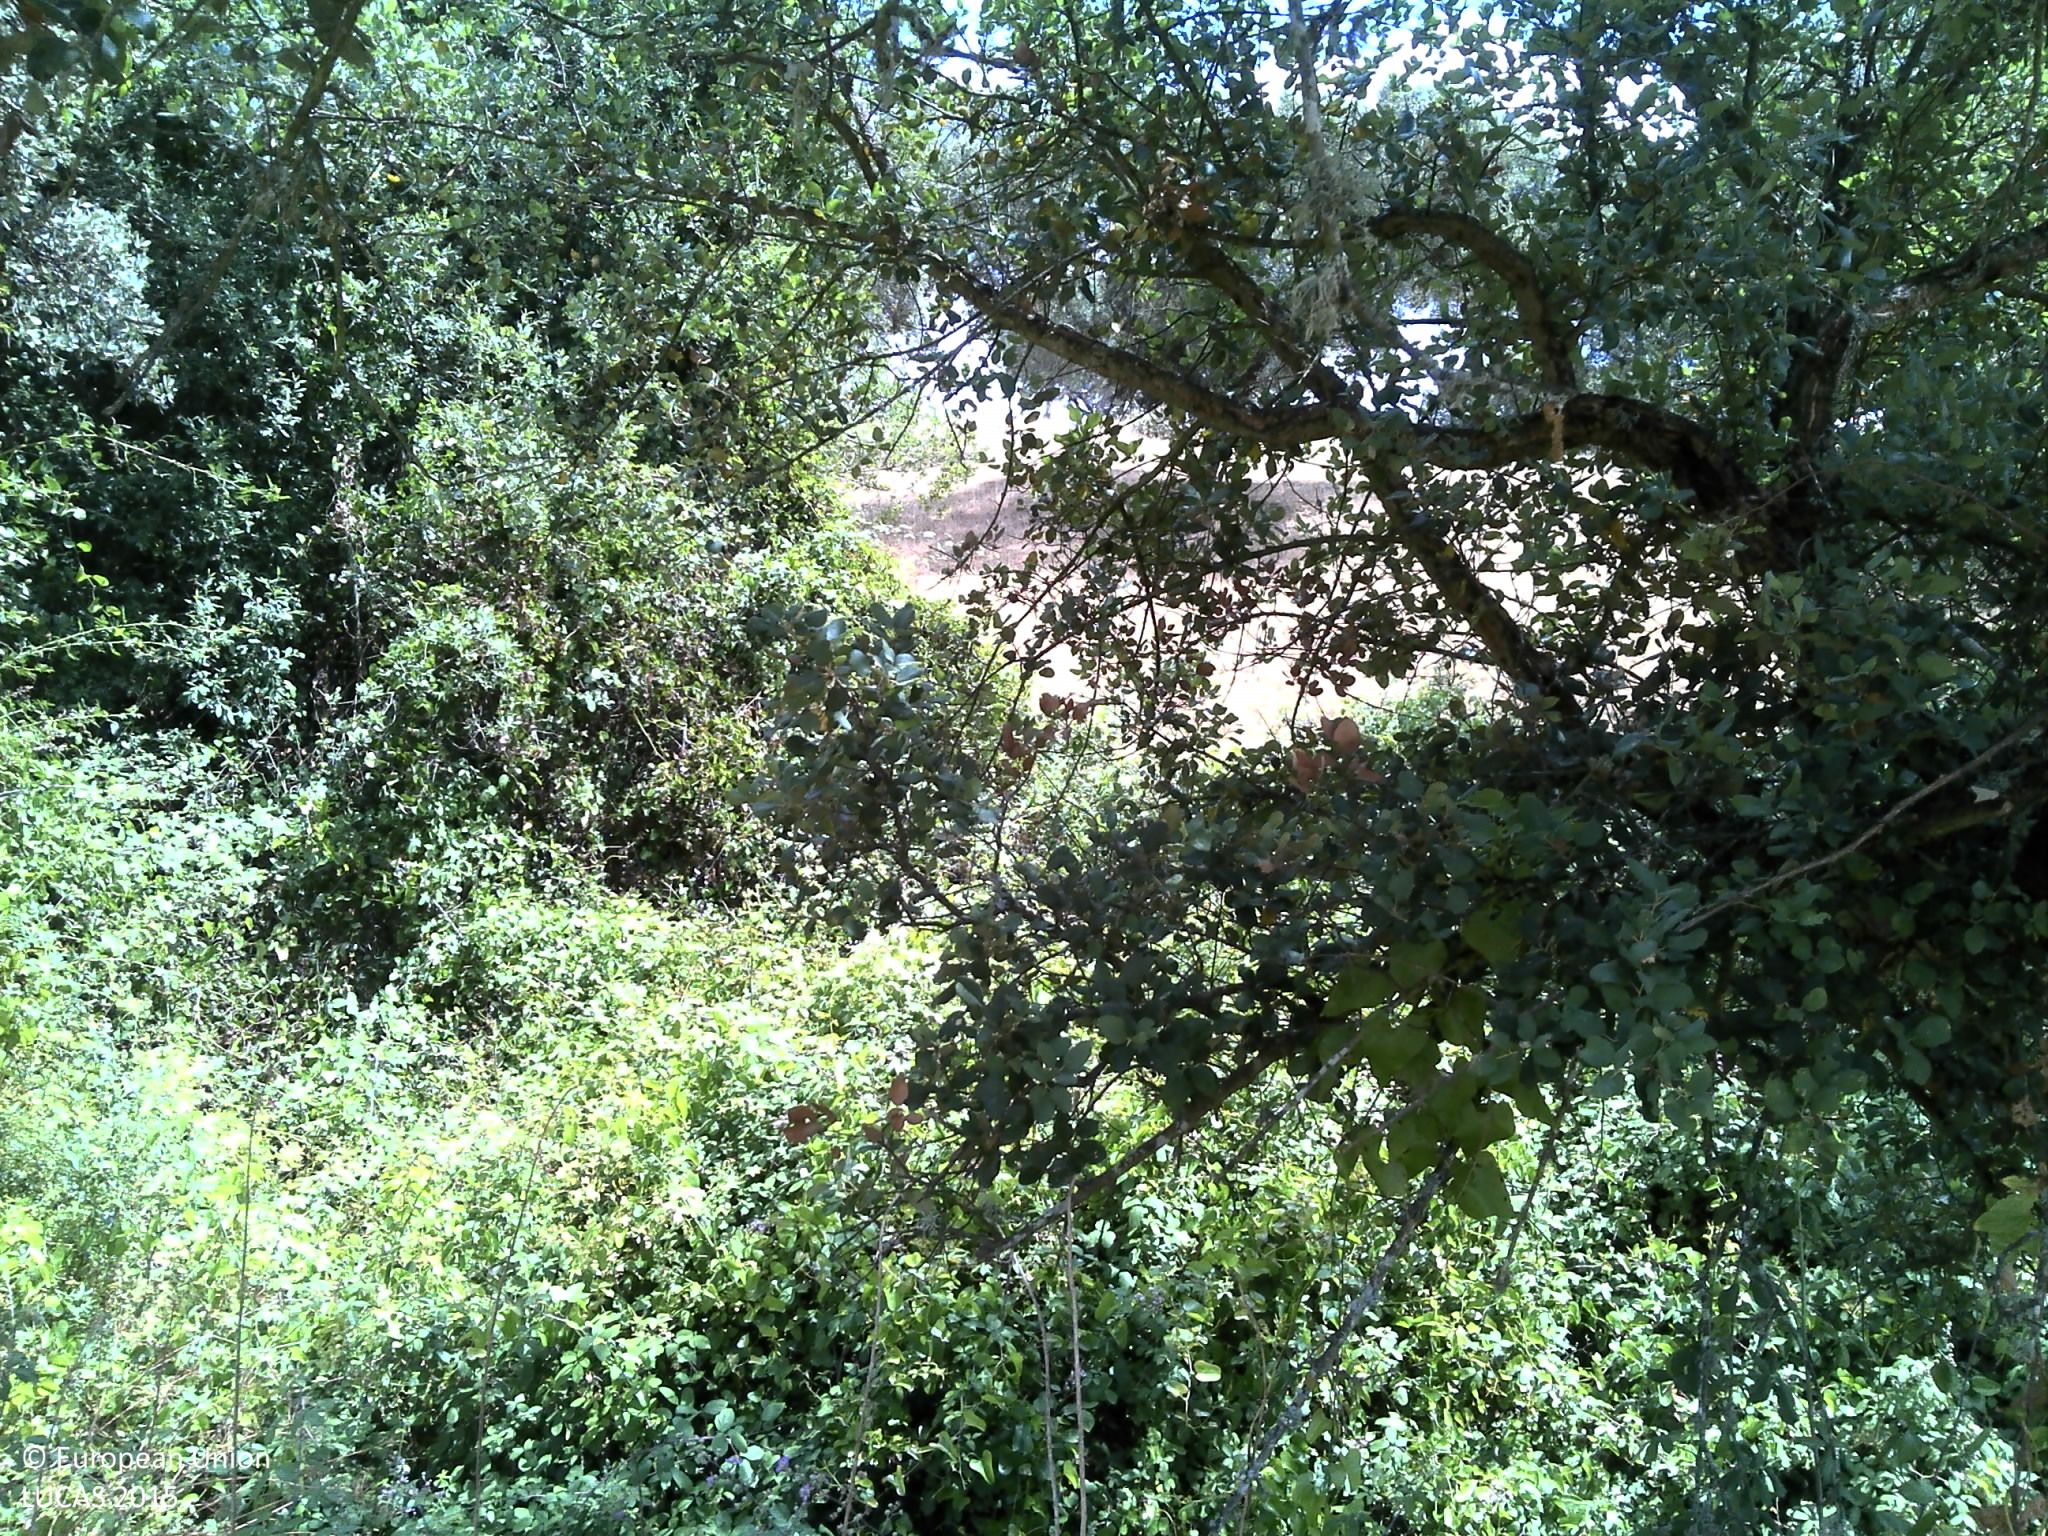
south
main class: Woodland
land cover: Broadleaved woodland
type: broadleaved evergreen forest
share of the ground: 10 - 25 %
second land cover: Shrubland without tree cover
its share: 50 - 75 %
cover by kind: shrubs 50 %, broadleaved forest trees 25 %, unconsolidated bare surface 20 %, herbaceous plants 5 %
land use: Forestry
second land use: Agriculture (excluding fallow land and kitchen gardens)
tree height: > 5 m
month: June
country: PT
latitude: 38.5507
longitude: -8.0930
